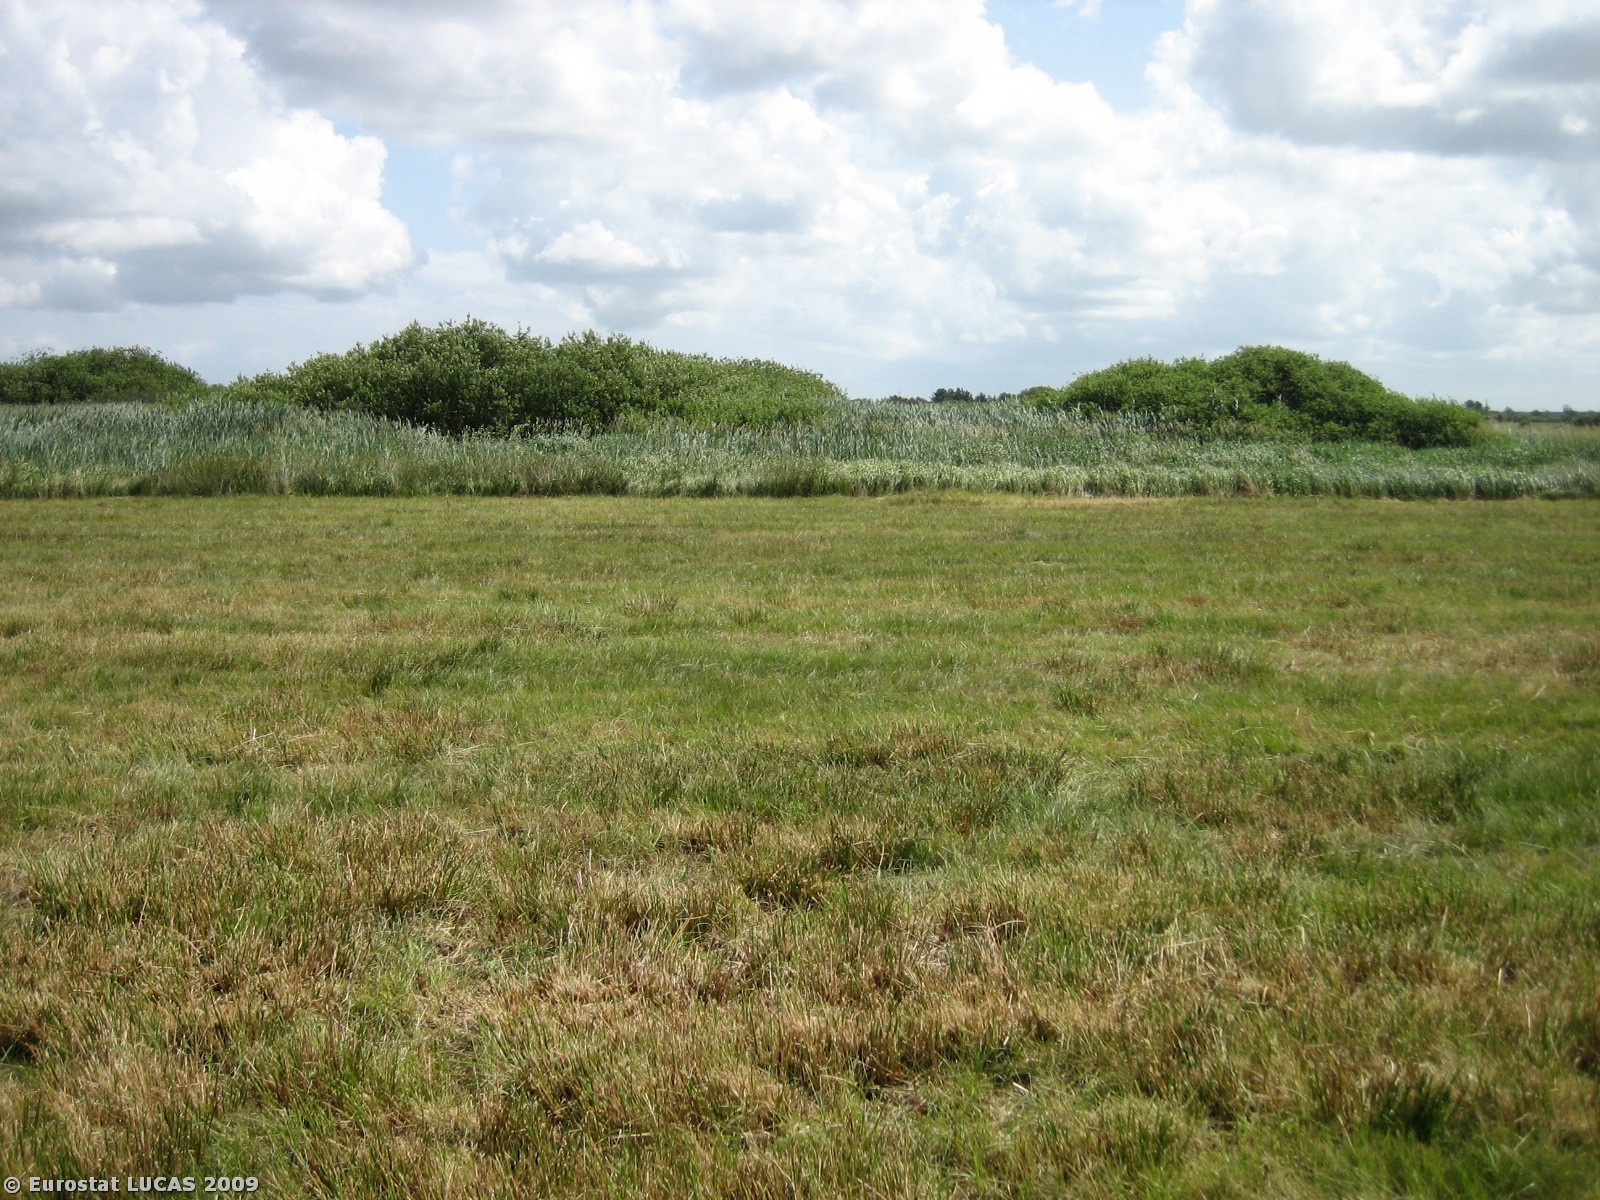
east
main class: Grassland
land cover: Grassland without tree/shrub cover
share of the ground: > 75 %
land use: Agriculture (excluding fallow land and kitchen gardens)
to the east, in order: Grassland without tree/shrub cover; Grass margins; Ditches and canals; Grass margins; Broadleaved woodland; Grassland without tree/shrub cover
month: July
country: DK
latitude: 55.6208
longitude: 8.4294
